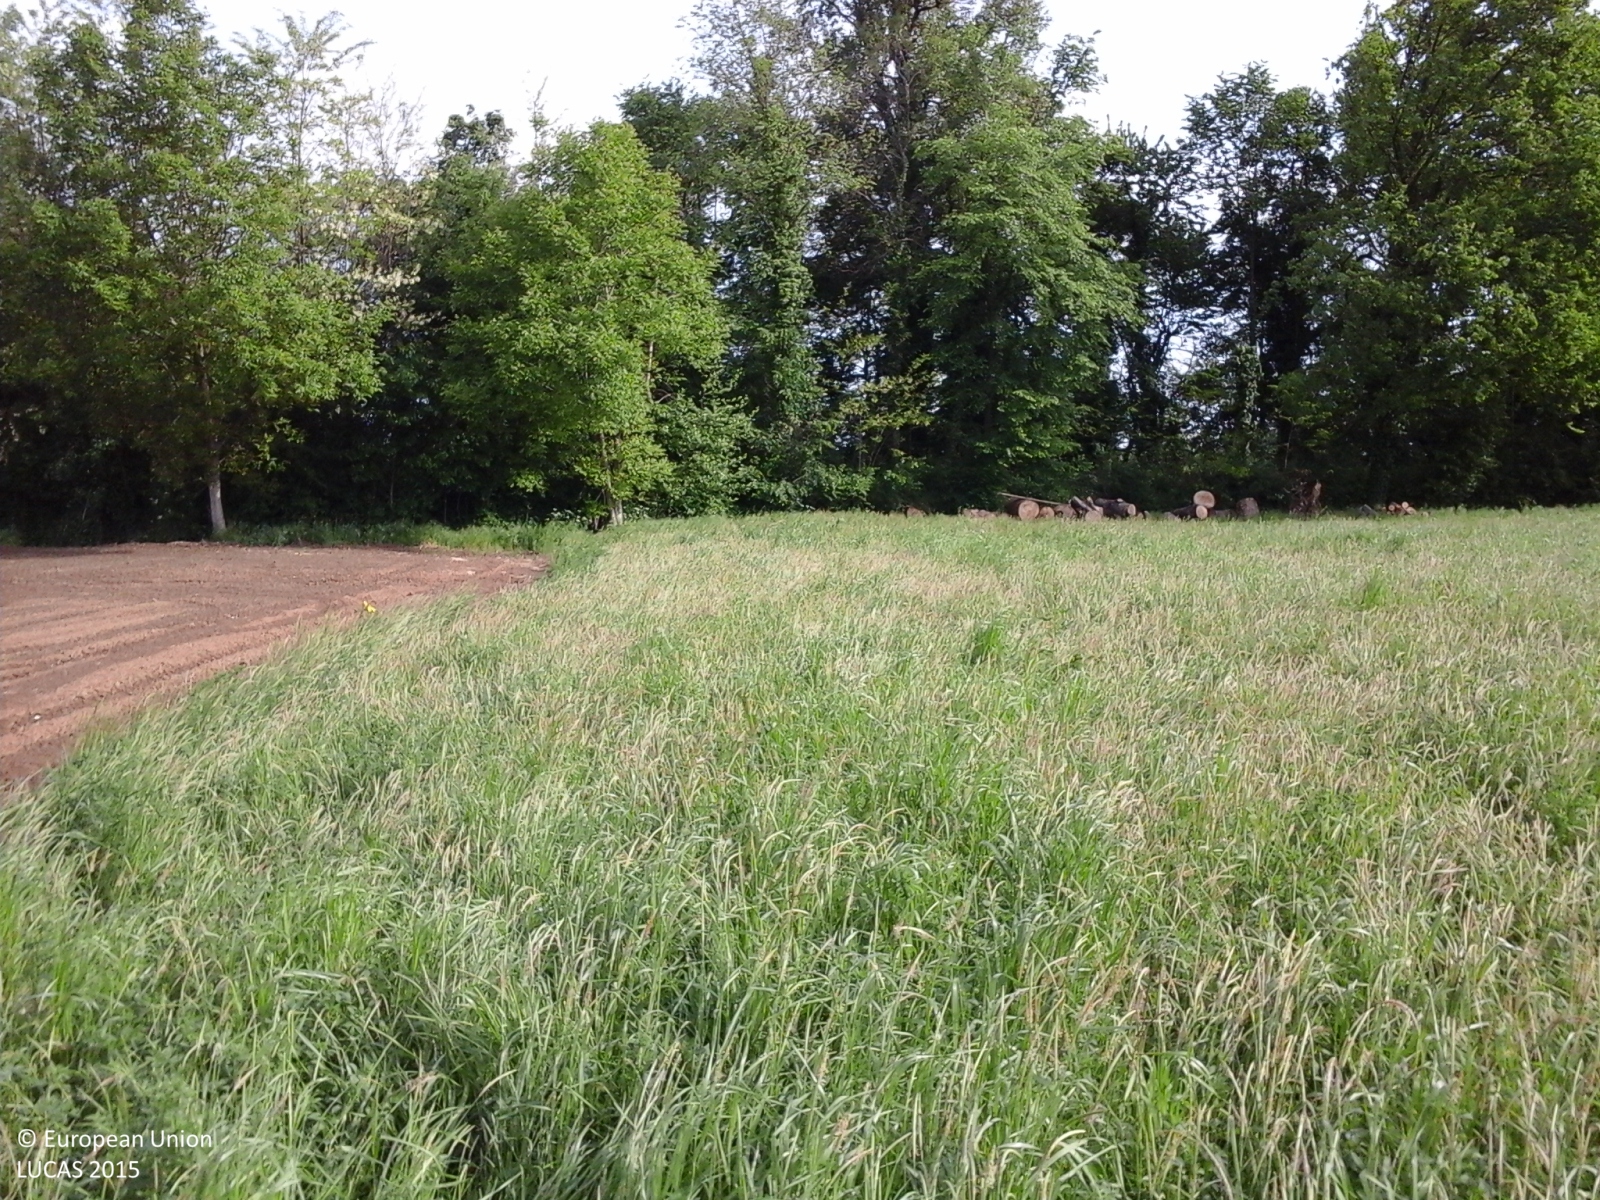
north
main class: Cropland
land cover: Lucerne
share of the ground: > 75 %
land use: Agriculture (excluding fallow land and kitchen gardens)
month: May
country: IT
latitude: 44.9807
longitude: 9.5570
